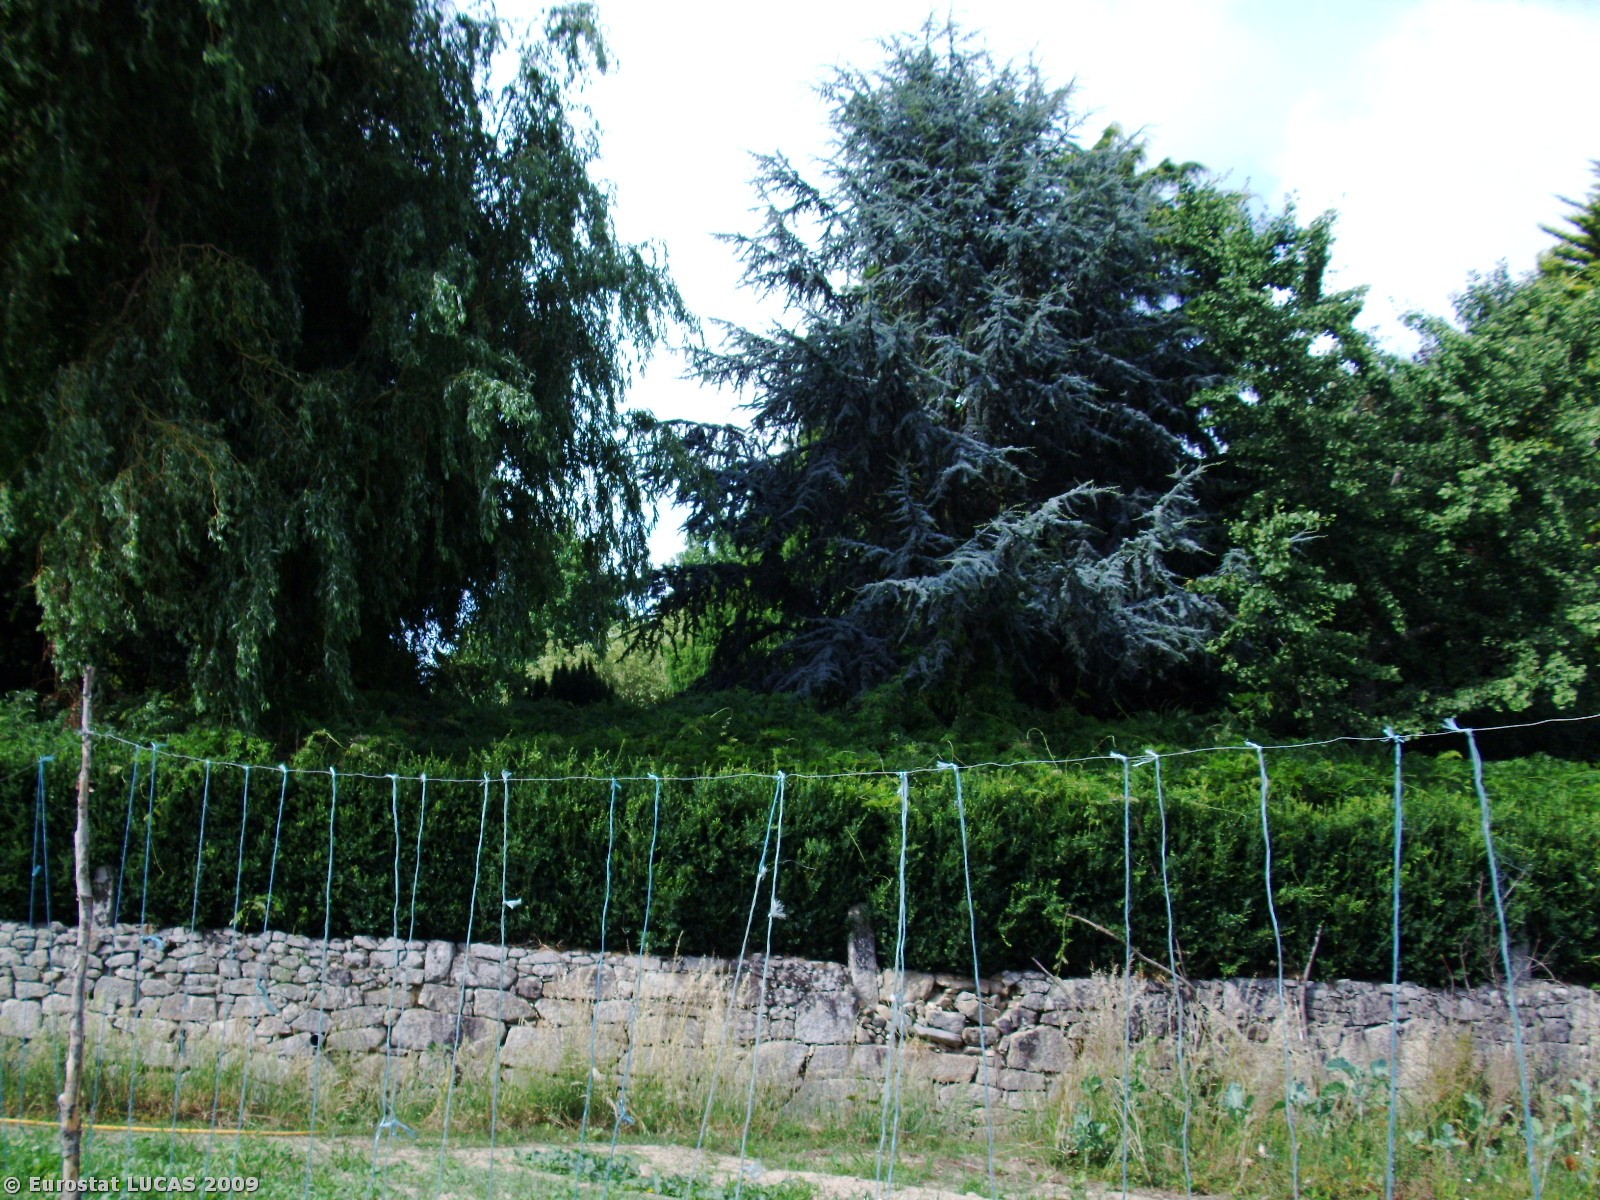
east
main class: Cropland
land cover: Other fresh vegetables
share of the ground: 50 - 75 %
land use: Agriculture (excluding fallow land and kitchen gardens)
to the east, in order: Other fresh vegetables; Spontaneously vegetated surfaces; Artificial constructions in urban areas; Arable land (only in case pi); Abandoned hedges; Arable land (only in case pi); Artificial constructions in urban areas
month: June
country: PT
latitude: 41.2038
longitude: -8.6263
